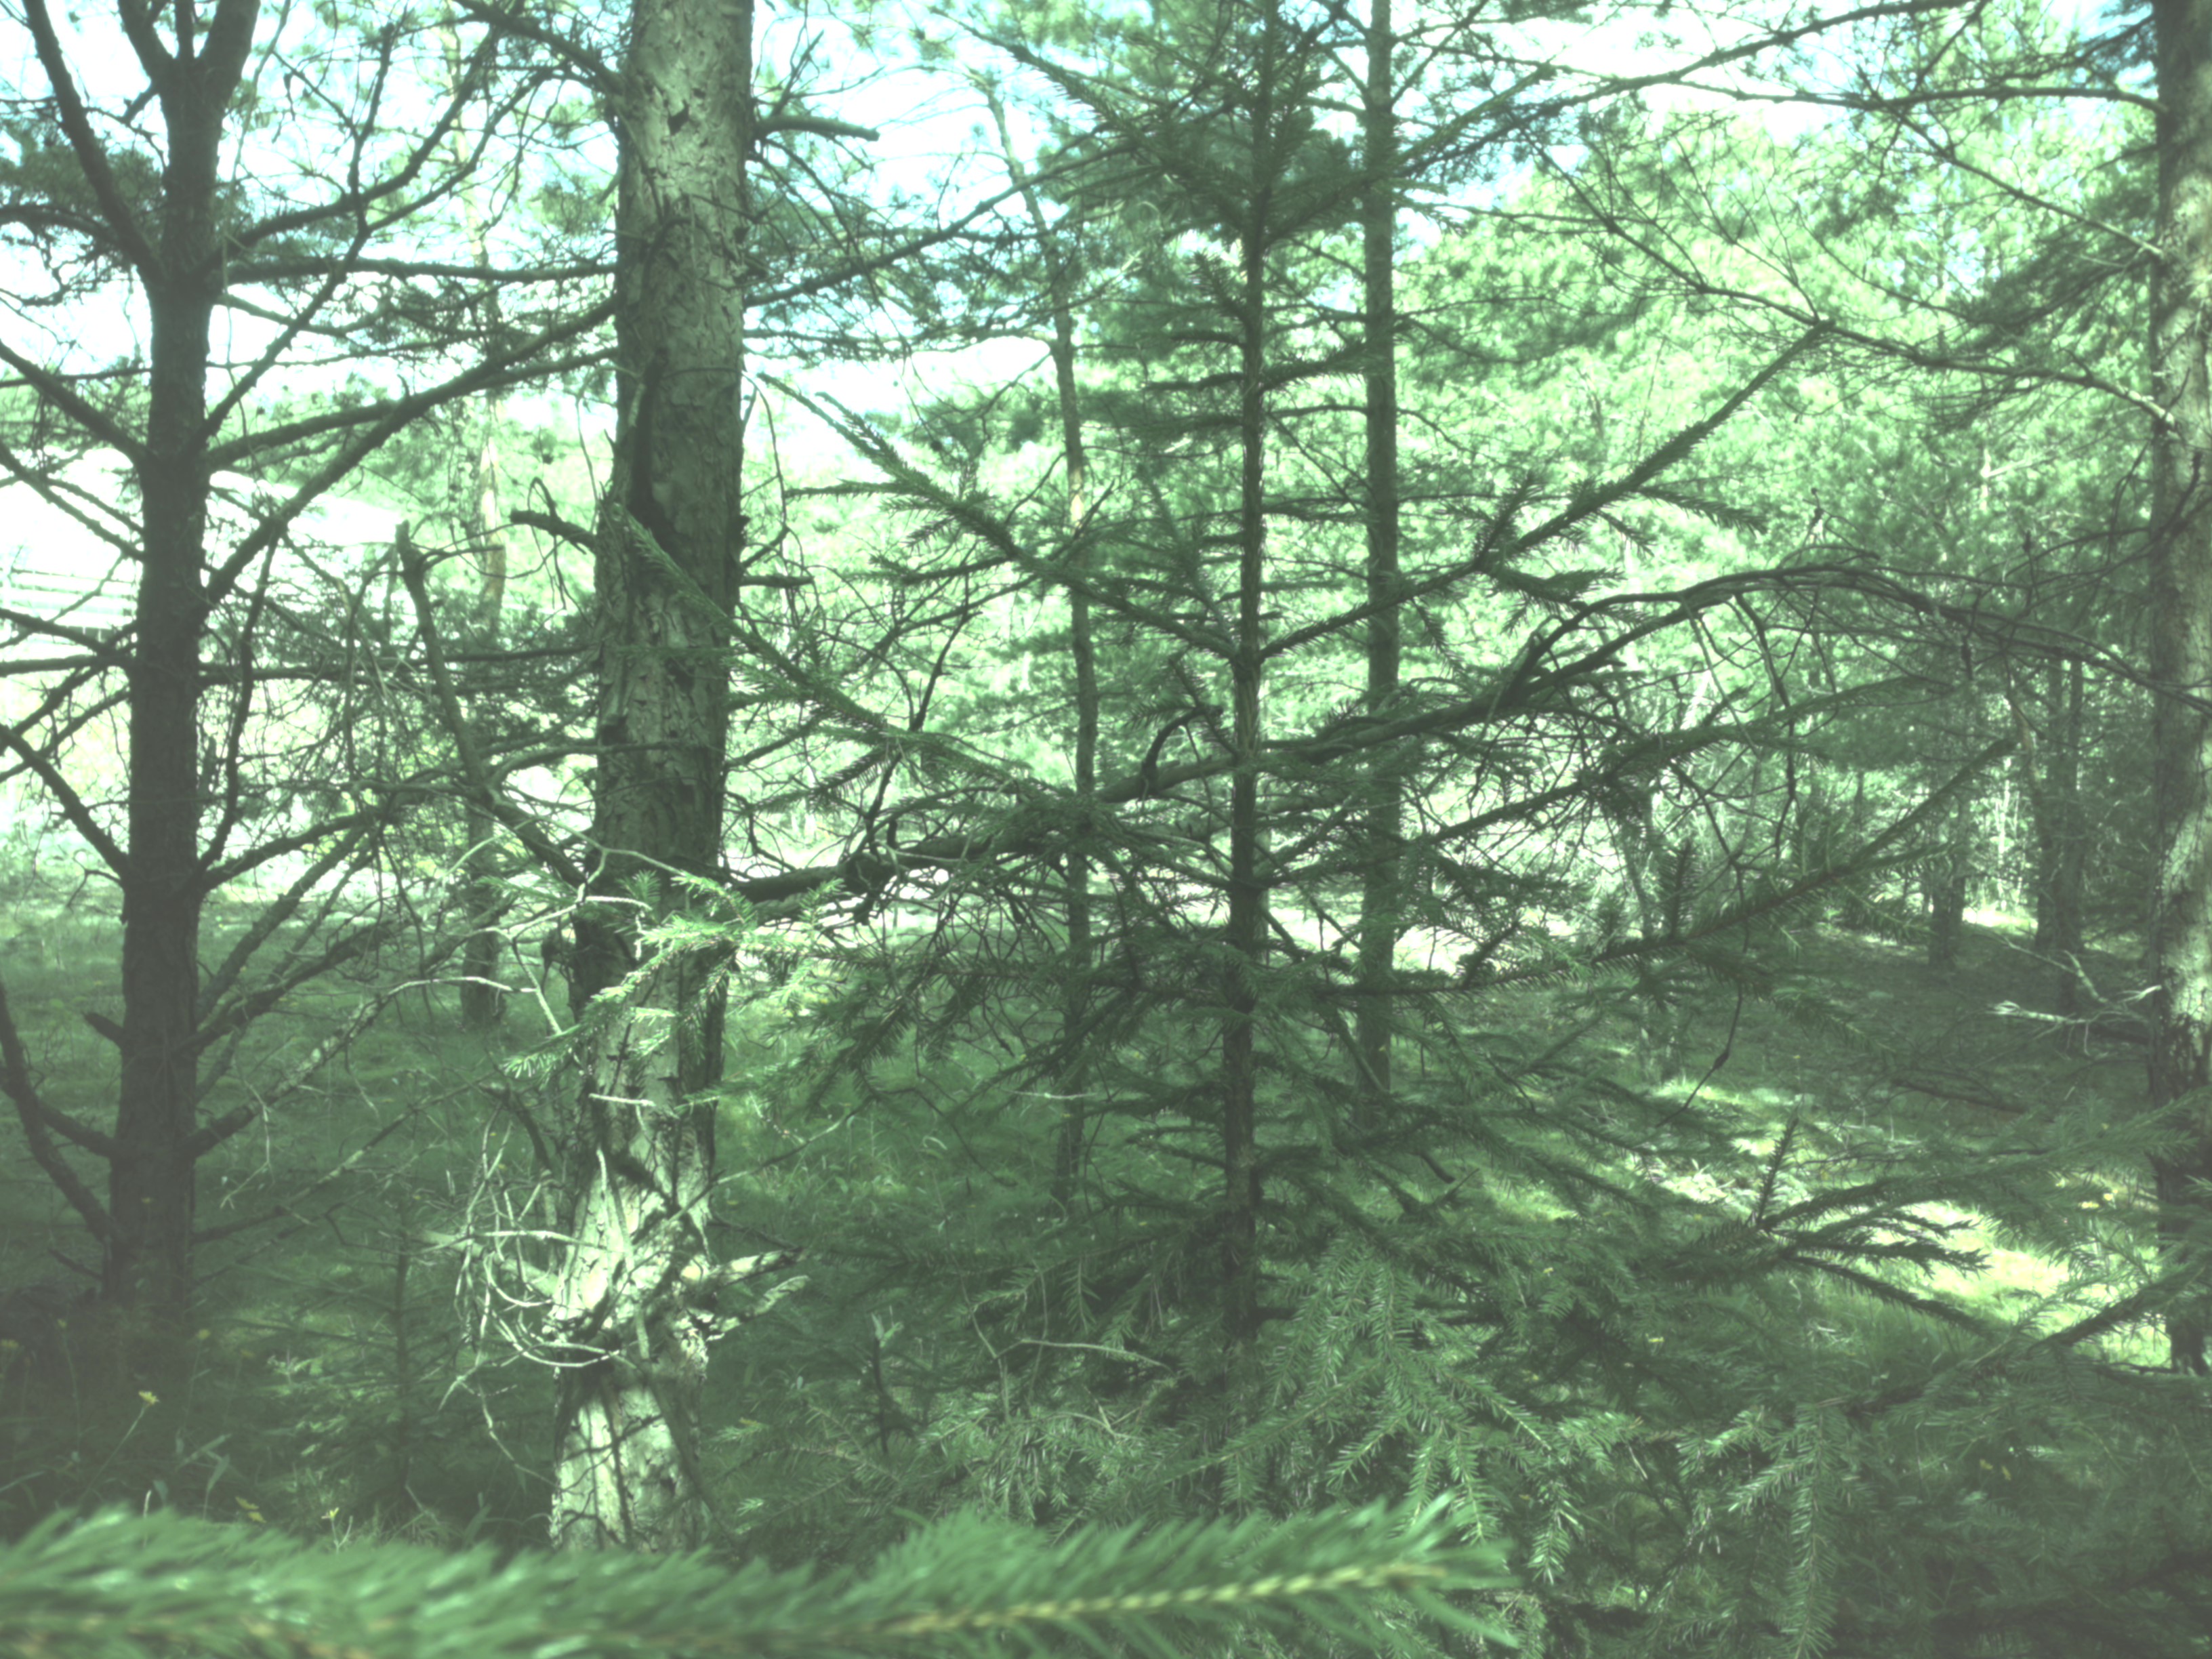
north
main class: Woodland
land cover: Pine dominated coniferous woodland
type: boreal forest
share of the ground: > 75 %
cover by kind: coniferous forest trees 75 %, lichens and mosses 20 %, broadleaved forest trees 5 %
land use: Forestry
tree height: > 5 m
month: August
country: SE
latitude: 59.1236
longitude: 17.6320
